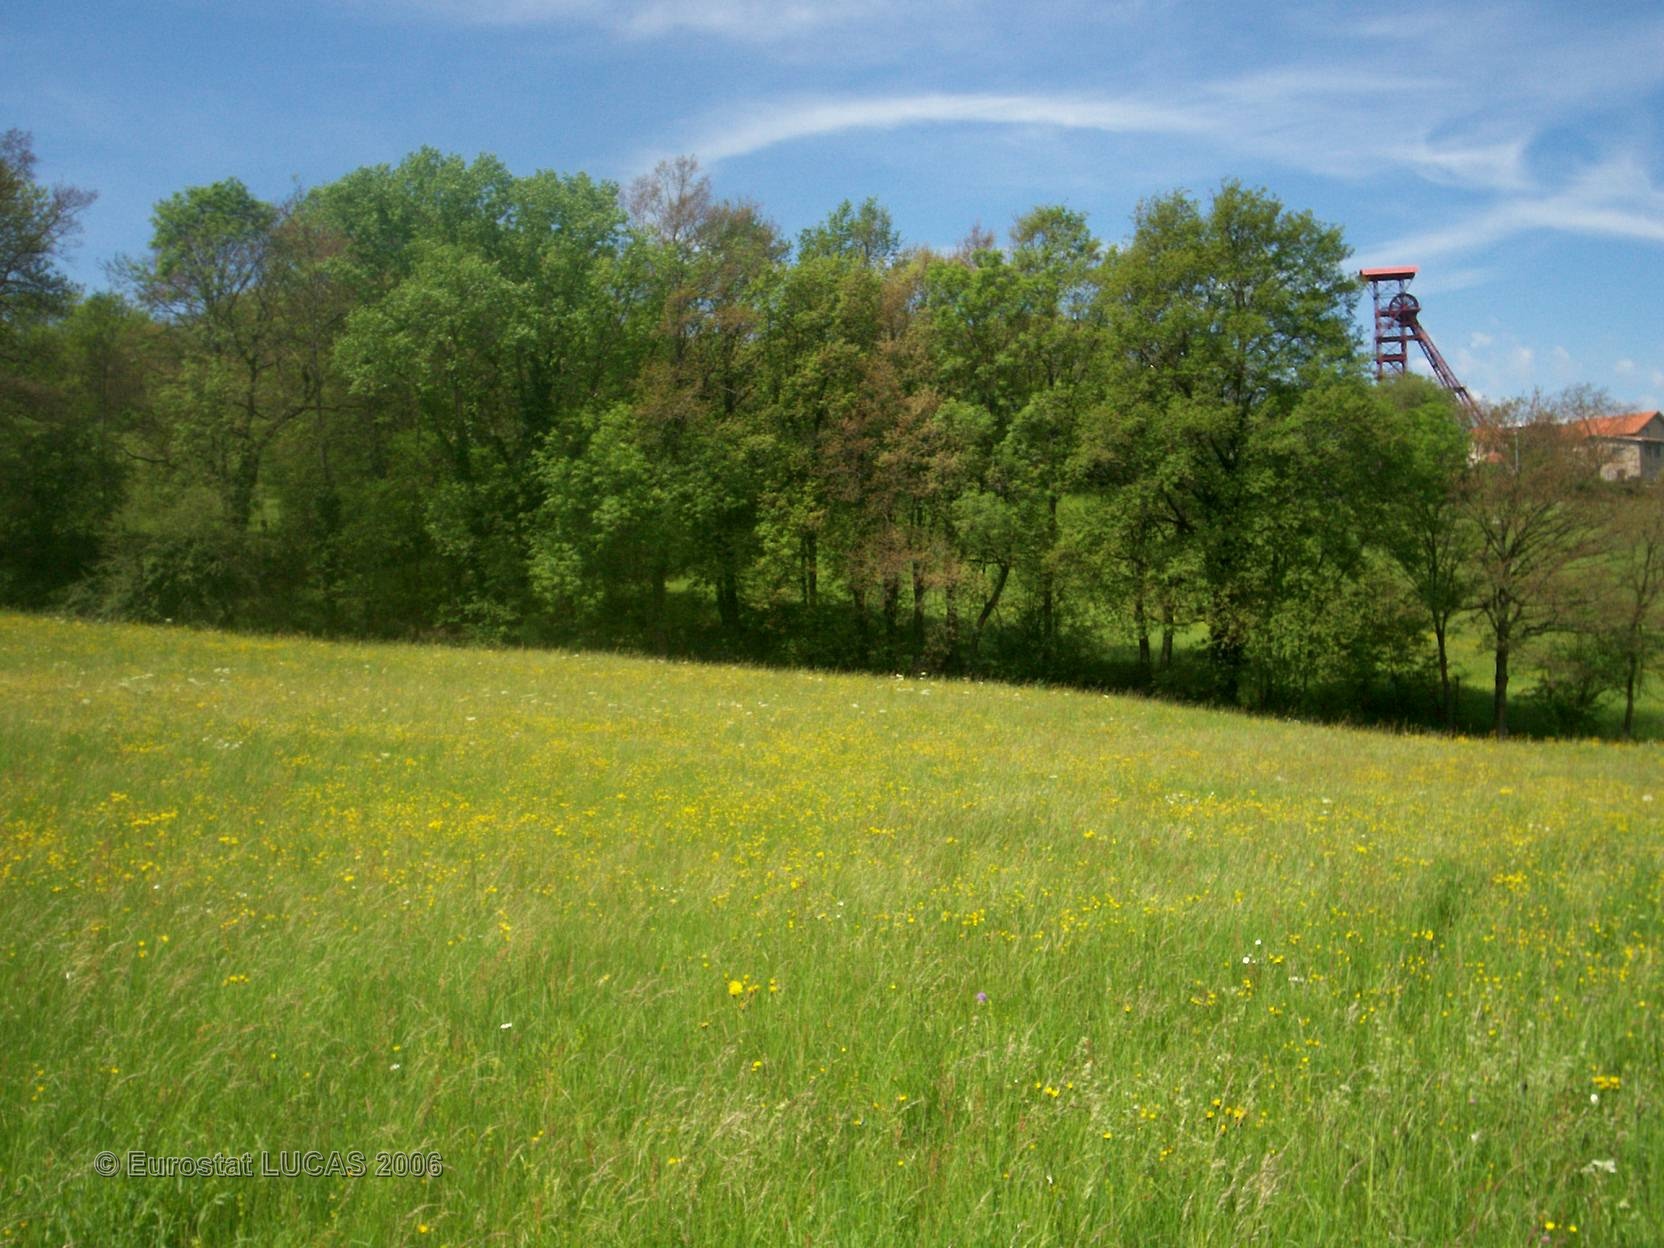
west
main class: Grassland
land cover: Grassland without tree/shrub cover
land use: Agriculture (excluding fallow land and kitchen gardens)
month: May
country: FR
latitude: 45.4371
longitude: 3.3158
